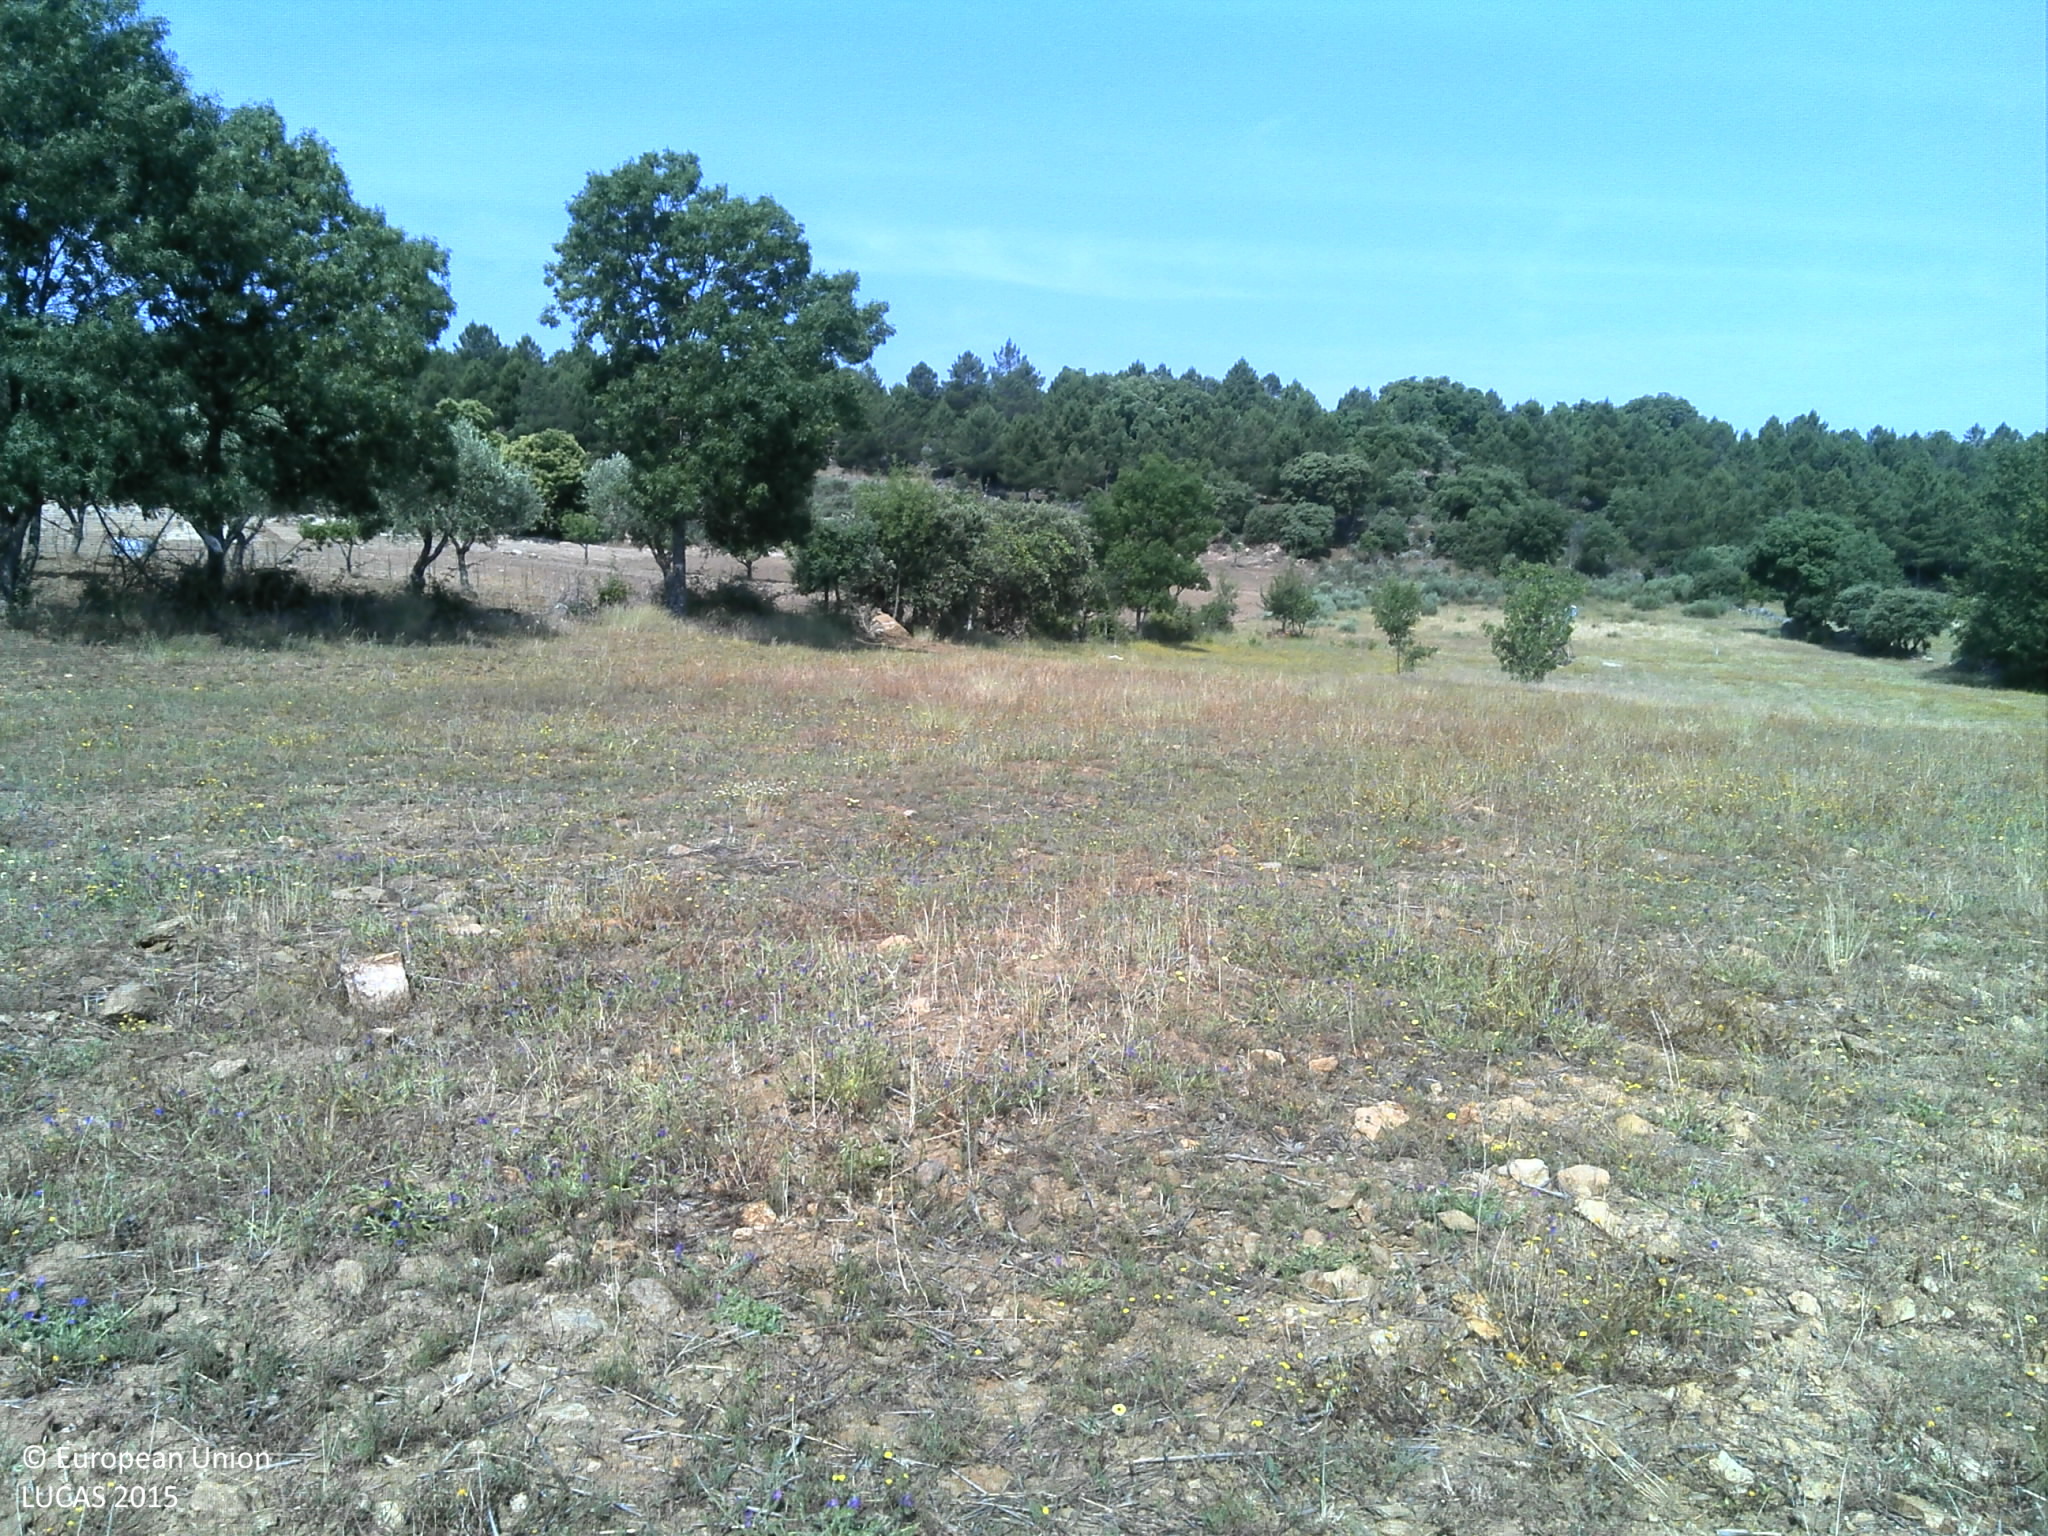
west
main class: Grassland
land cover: Grassland without tree/shrub cover
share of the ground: 25 - 50 %
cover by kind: unconsolidated bare surface 60 %, herbaceous plants 30 %, consolidated bare surface 10 %
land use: Agriculture (excluding fallow land and kitchen gardens)
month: June
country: PT
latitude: 41.5097
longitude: -7.0453
